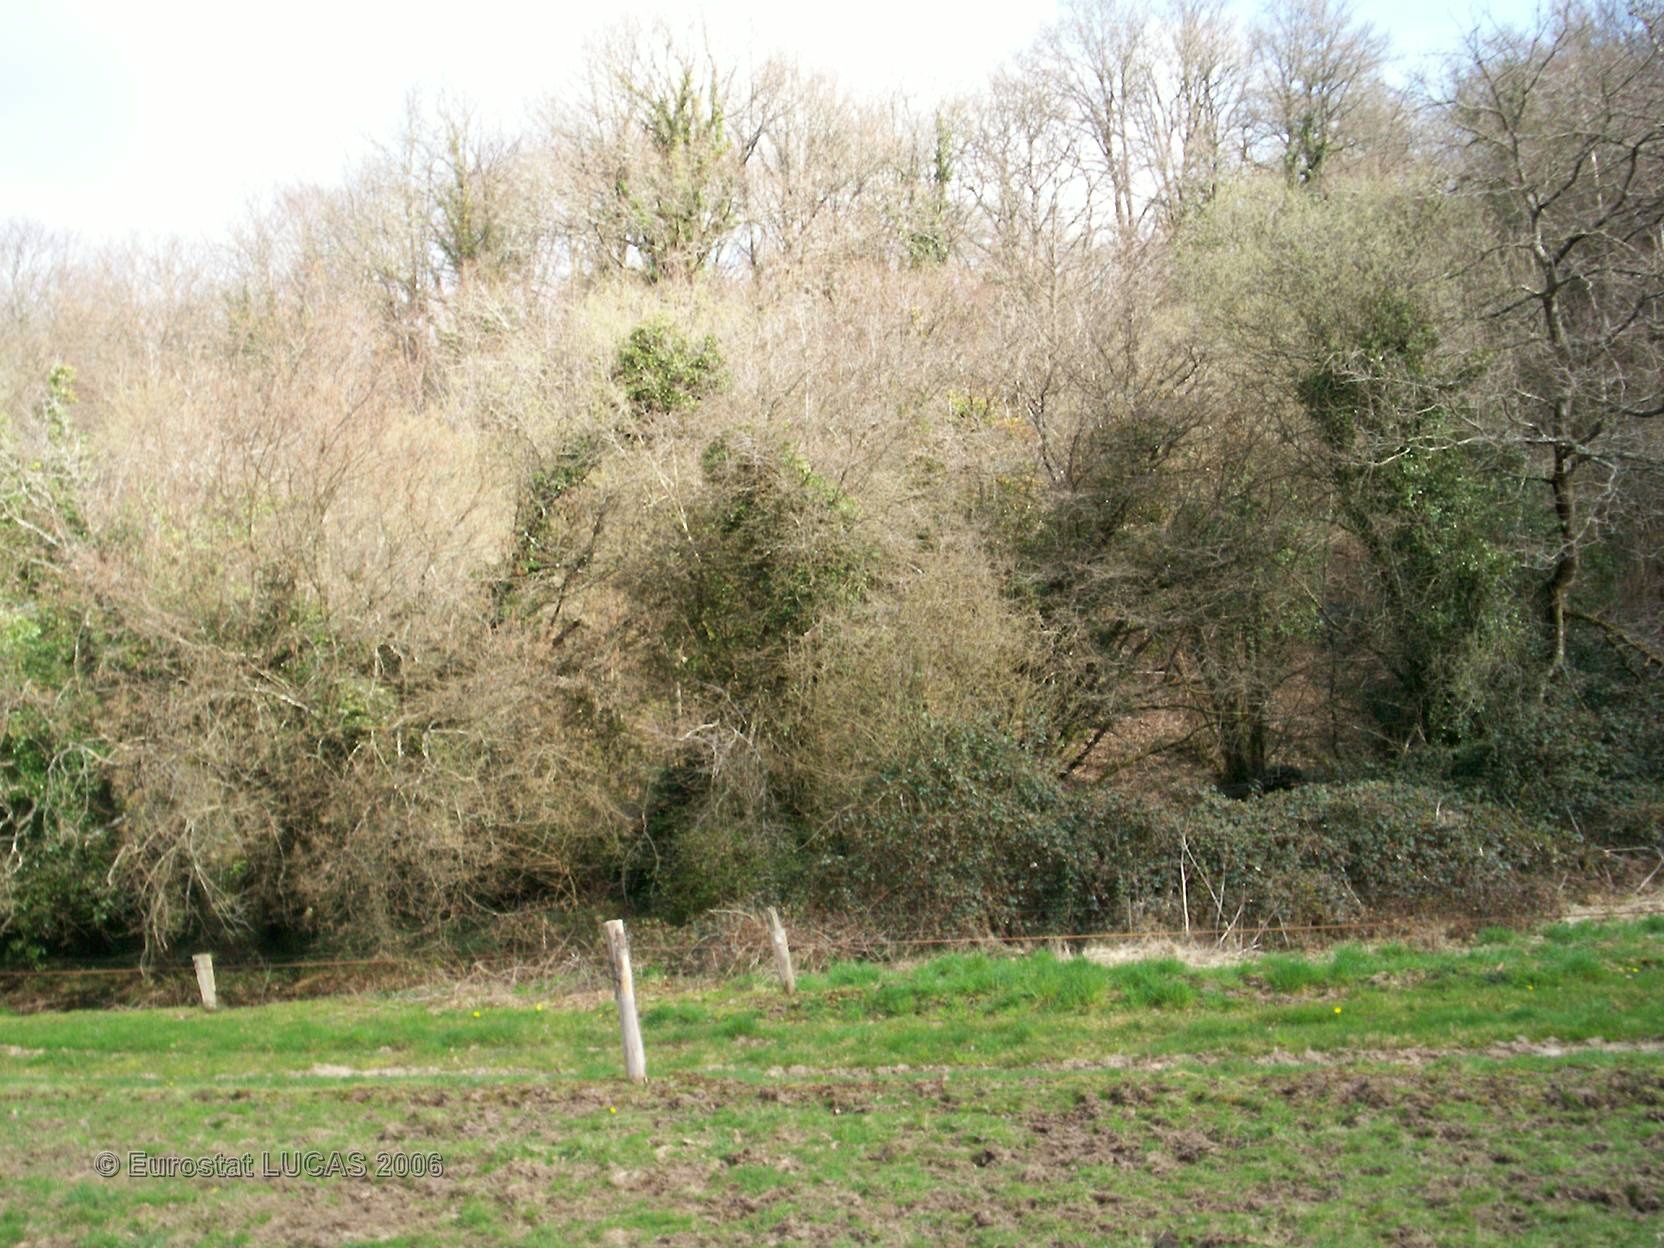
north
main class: Grassland
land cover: Grassland without tree/shrub cover
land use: Agriculture (excluding fallow land and kitchen gardens)
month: April
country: FR
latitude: 48.0590
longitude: -3.5357
